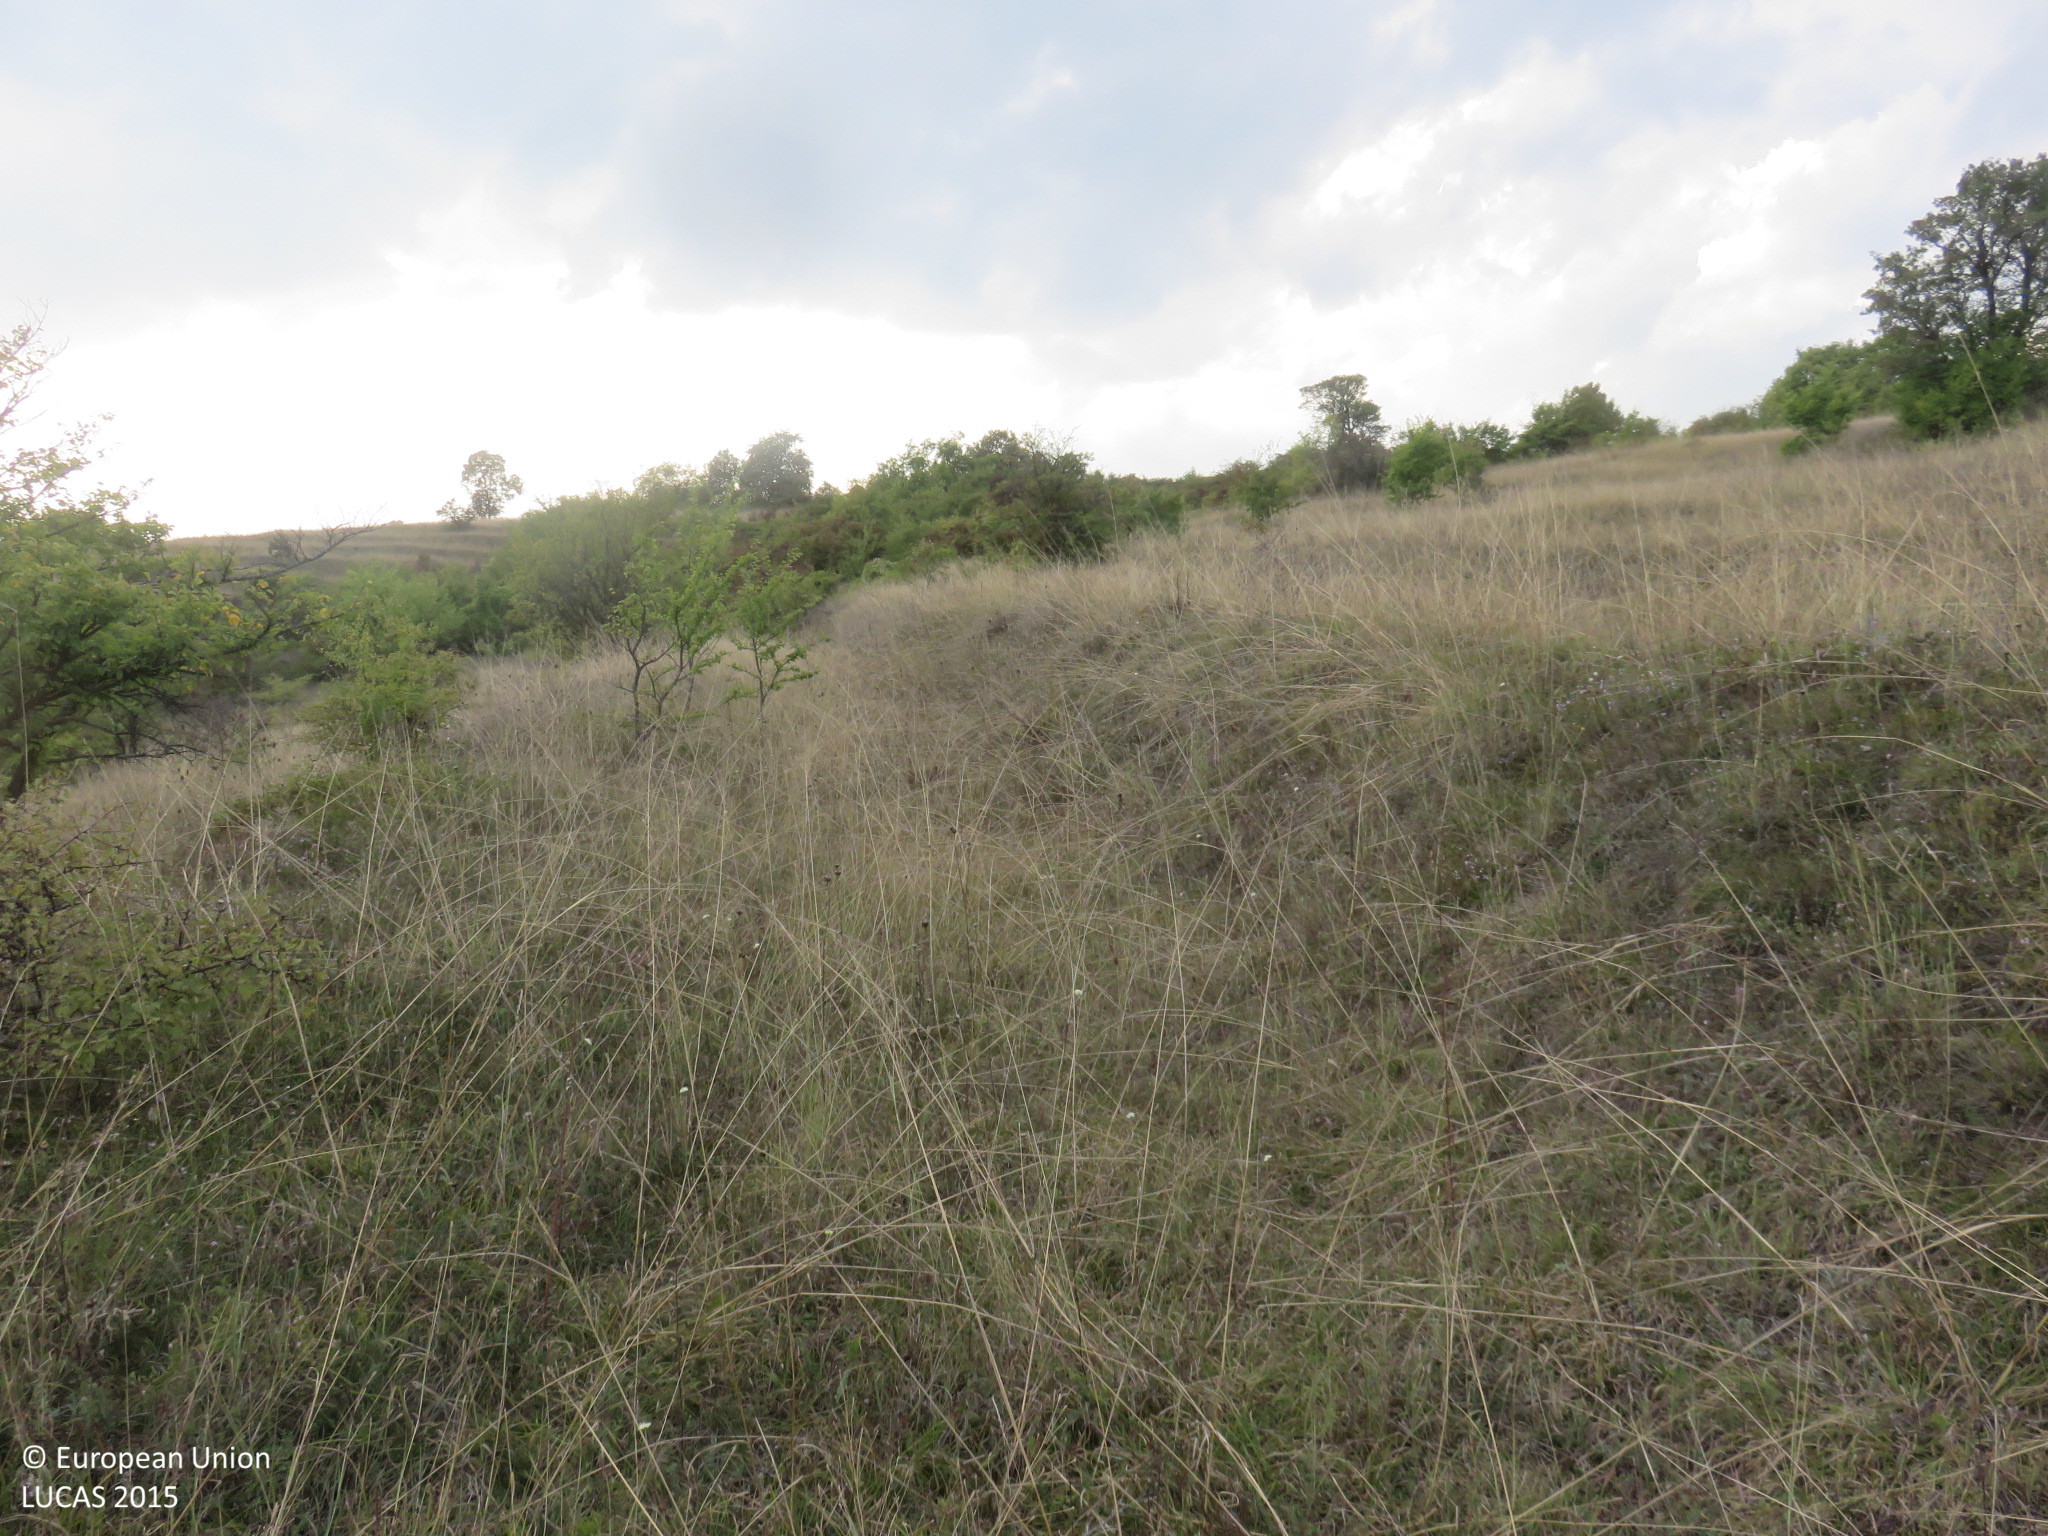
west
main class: Grassland
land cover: Grassland with sparse tree/shrub cover
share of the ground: > 75 %
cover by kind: herbaceous plants 90 %, broadleaved forest trees 5 %, shrubs 5 %
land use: Semi-natural and natural areas not in use
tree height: < 5 m
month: September
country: BG
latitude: 43.1032
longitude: 25.0210
